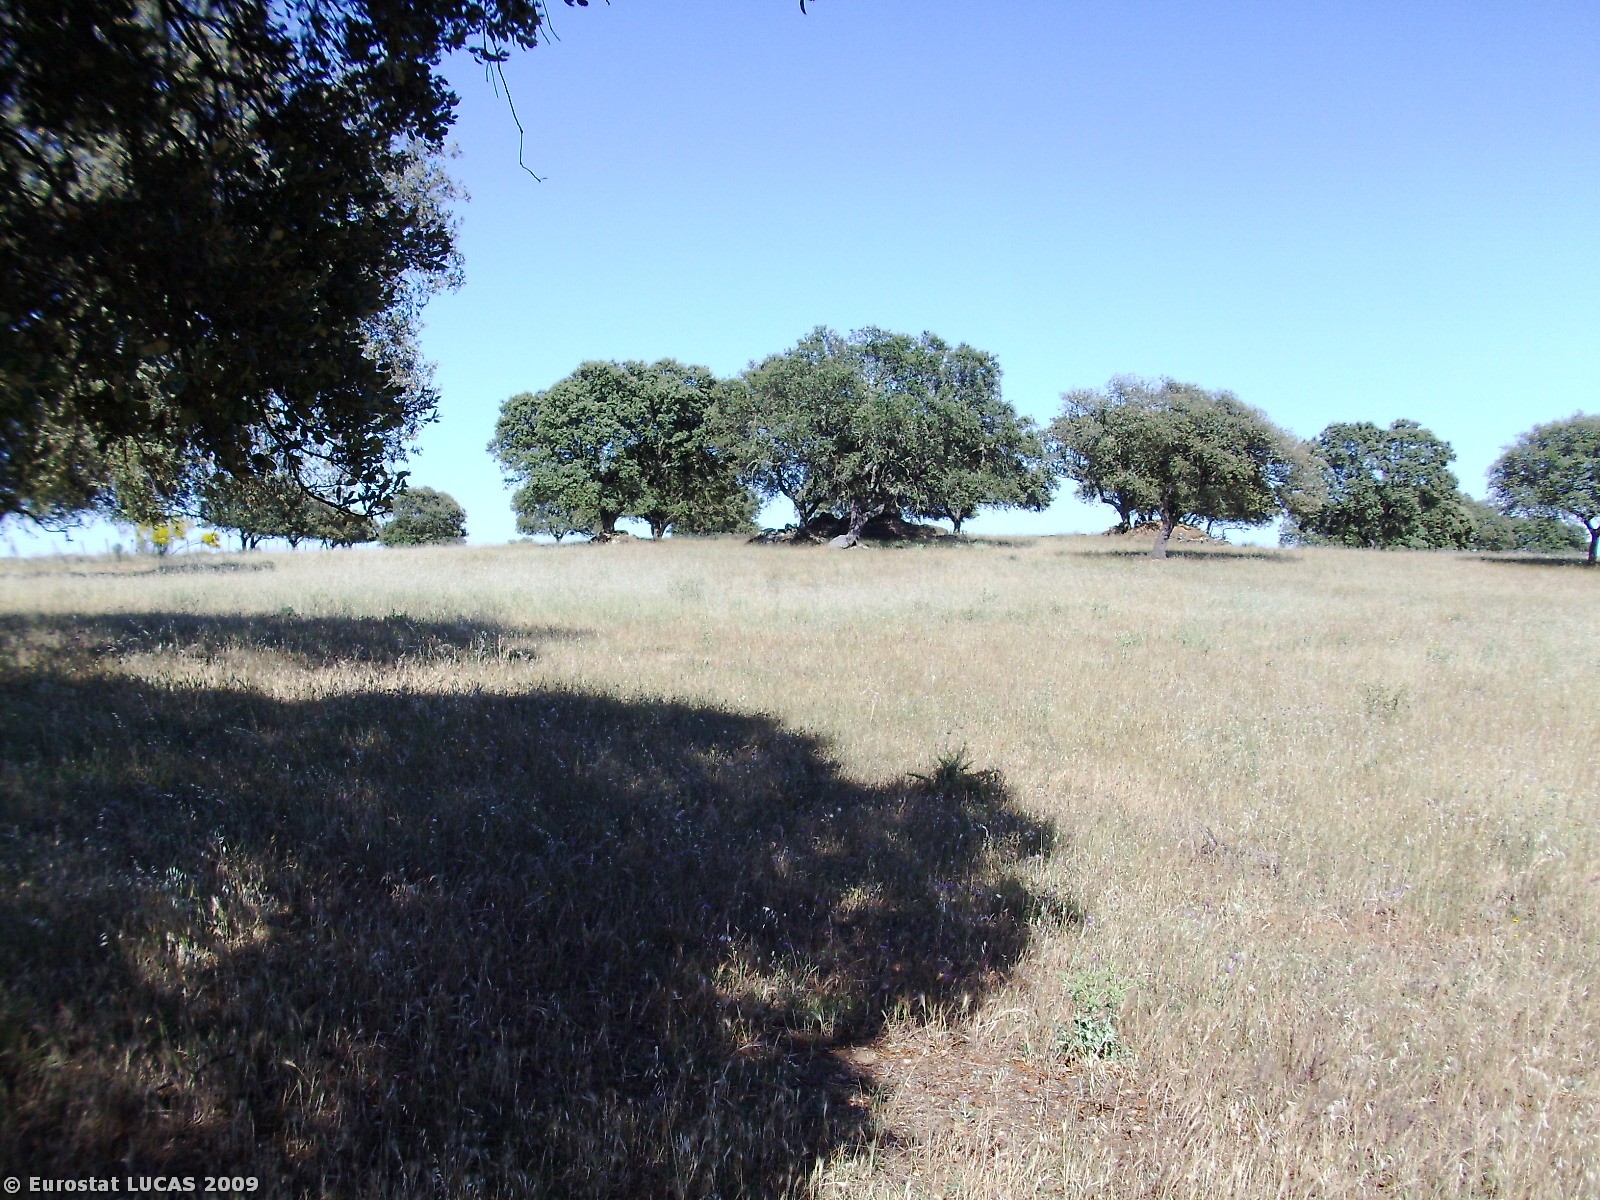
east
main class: Woodland
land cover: Broadleaved woodland
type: broadleaved evergreen forest
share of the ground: 10 - 25 %
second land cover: Grassland with sparse tree/shrub cover
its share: 50 - 75 %
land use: Forestry
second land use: Agriculture (excluding fallow land and kitchen gardens)
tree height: > 5 m
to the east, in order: Broadleaved woodland; Grassland with sparse tree/shrub cover; Broadleaved woodland
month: May
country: PT
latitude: 38.9612
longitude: -7.3795
